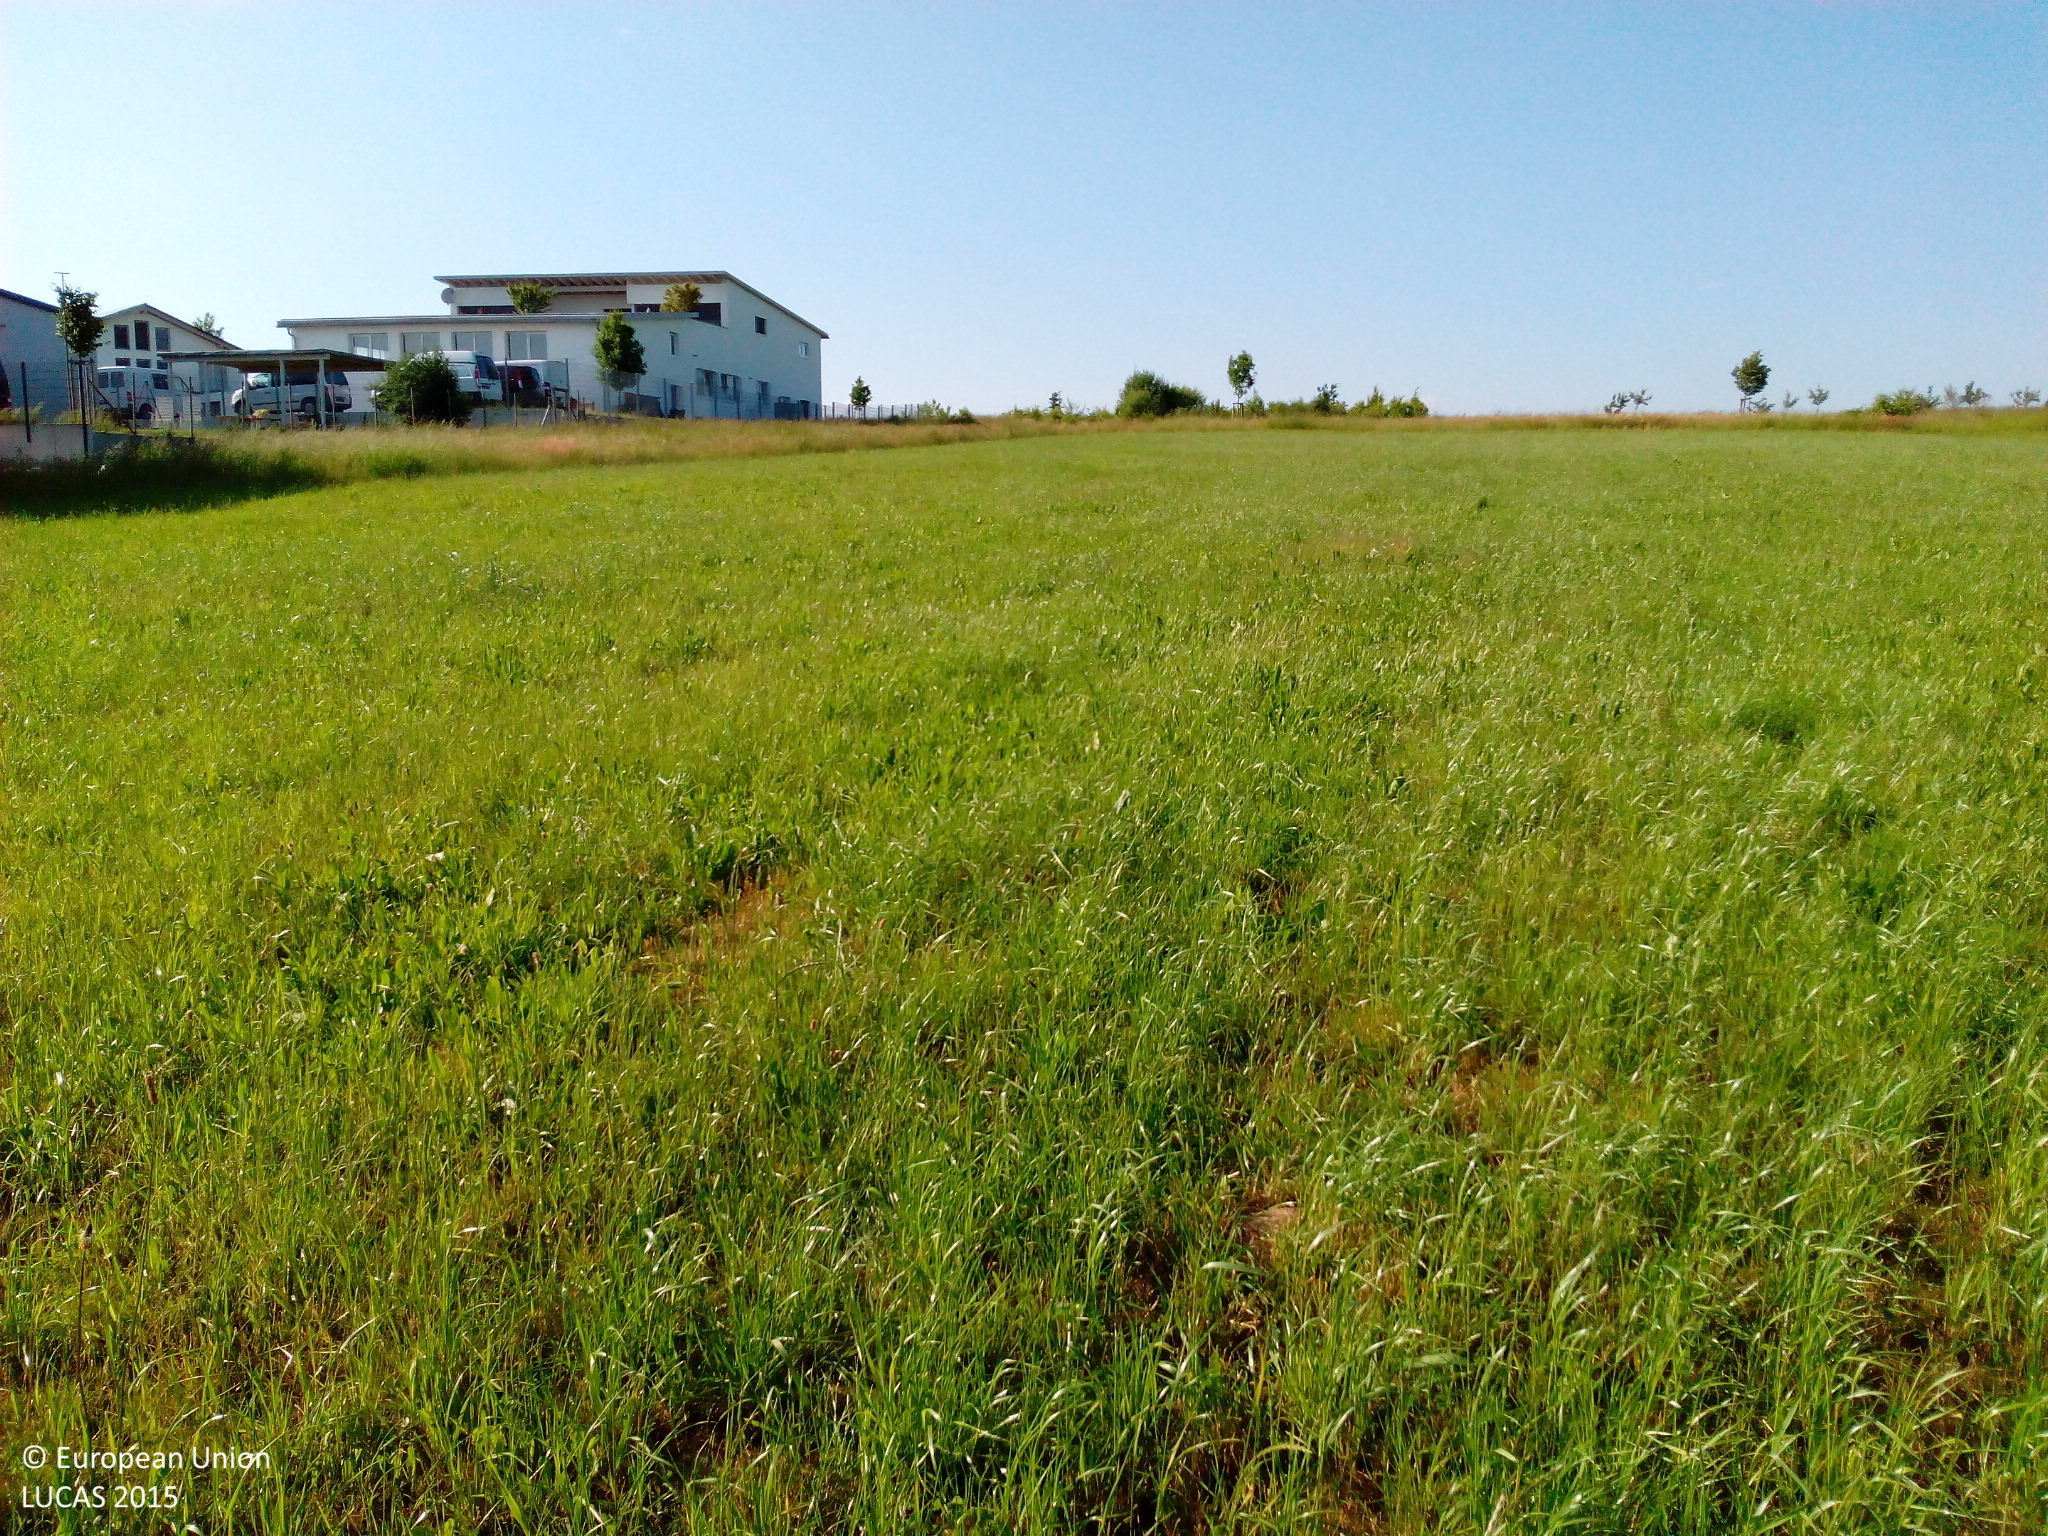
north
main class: Grassland
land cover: Grassland without tree/shrub cover
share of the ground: > 75 %
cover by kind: herbaceous plants 100 %
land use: Agriculture (excluding fallow land and kitchen gardens)
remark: Harvested field
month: June
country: DE
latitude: 48.9057
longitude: 9.4136
